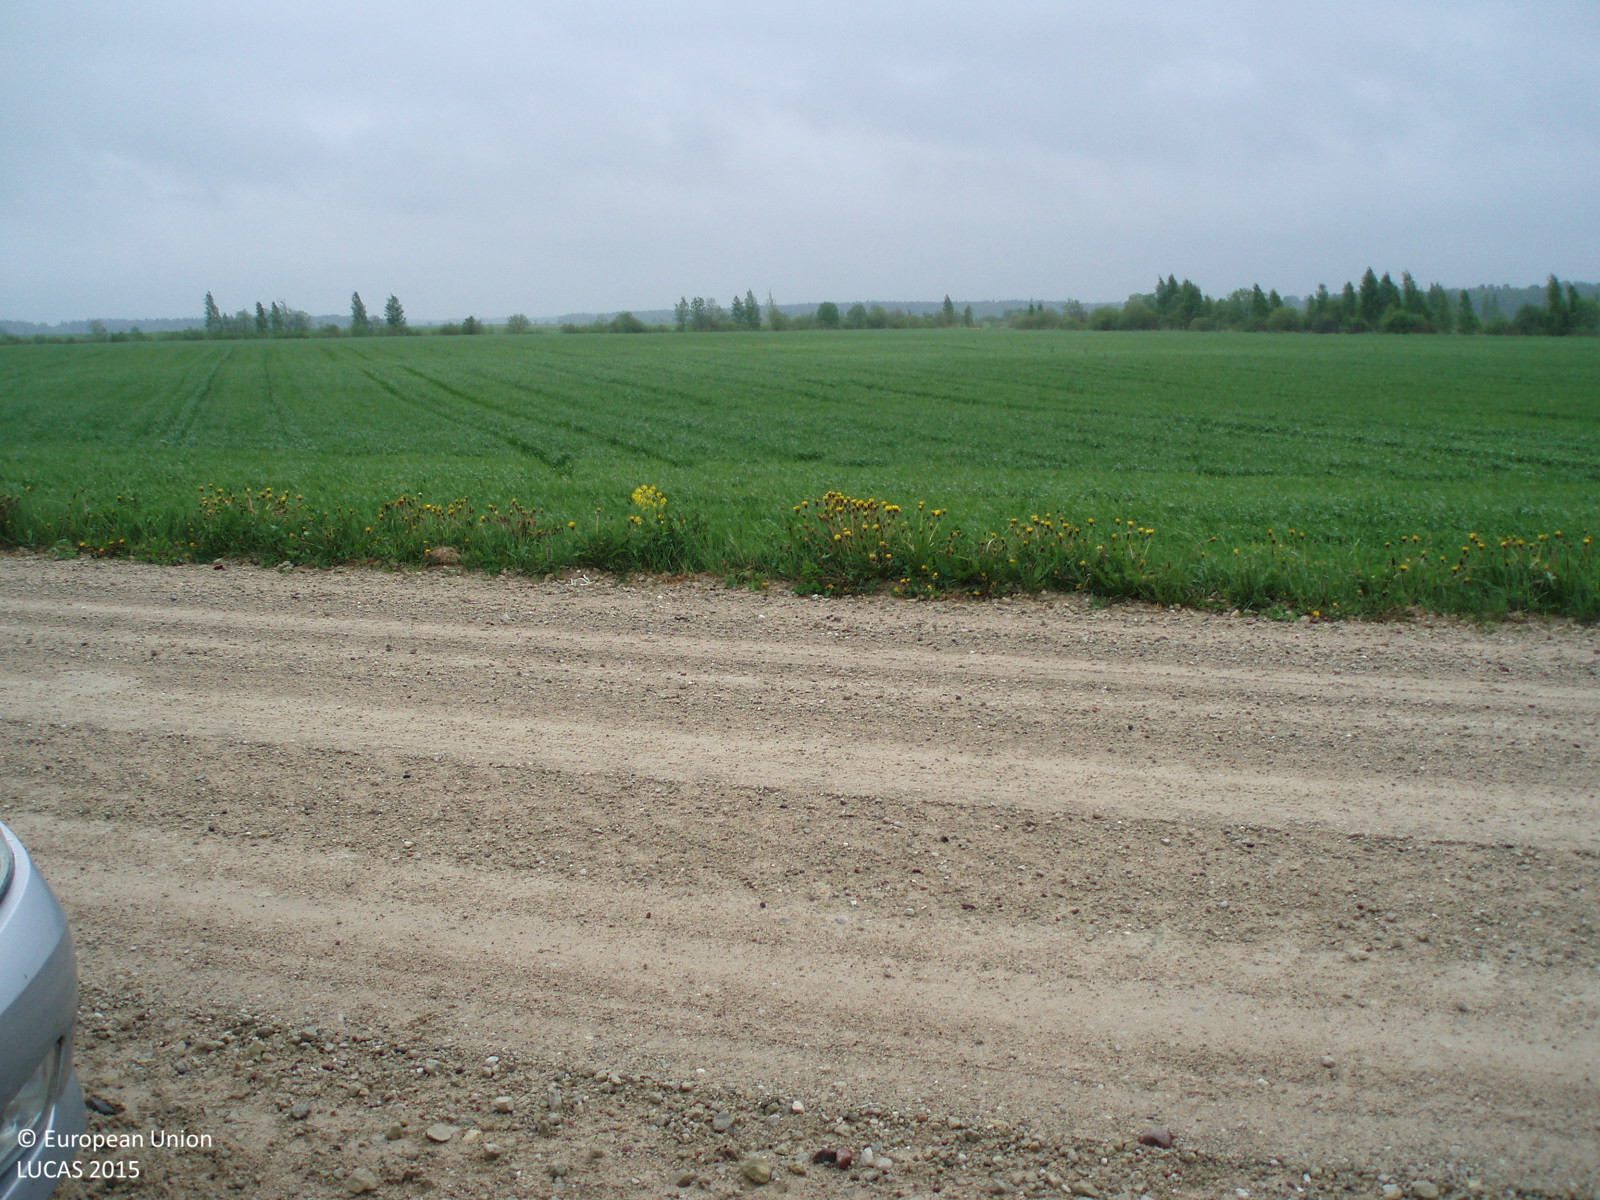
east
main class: Cropland
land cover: Rape and turnip rape
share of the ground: > 75 %
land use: Agriculture (excluding fallow land and kitchen gardens)
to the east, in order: Rape and turnip rape
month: May
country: LT
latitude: 56.3507
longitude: 22.9297
